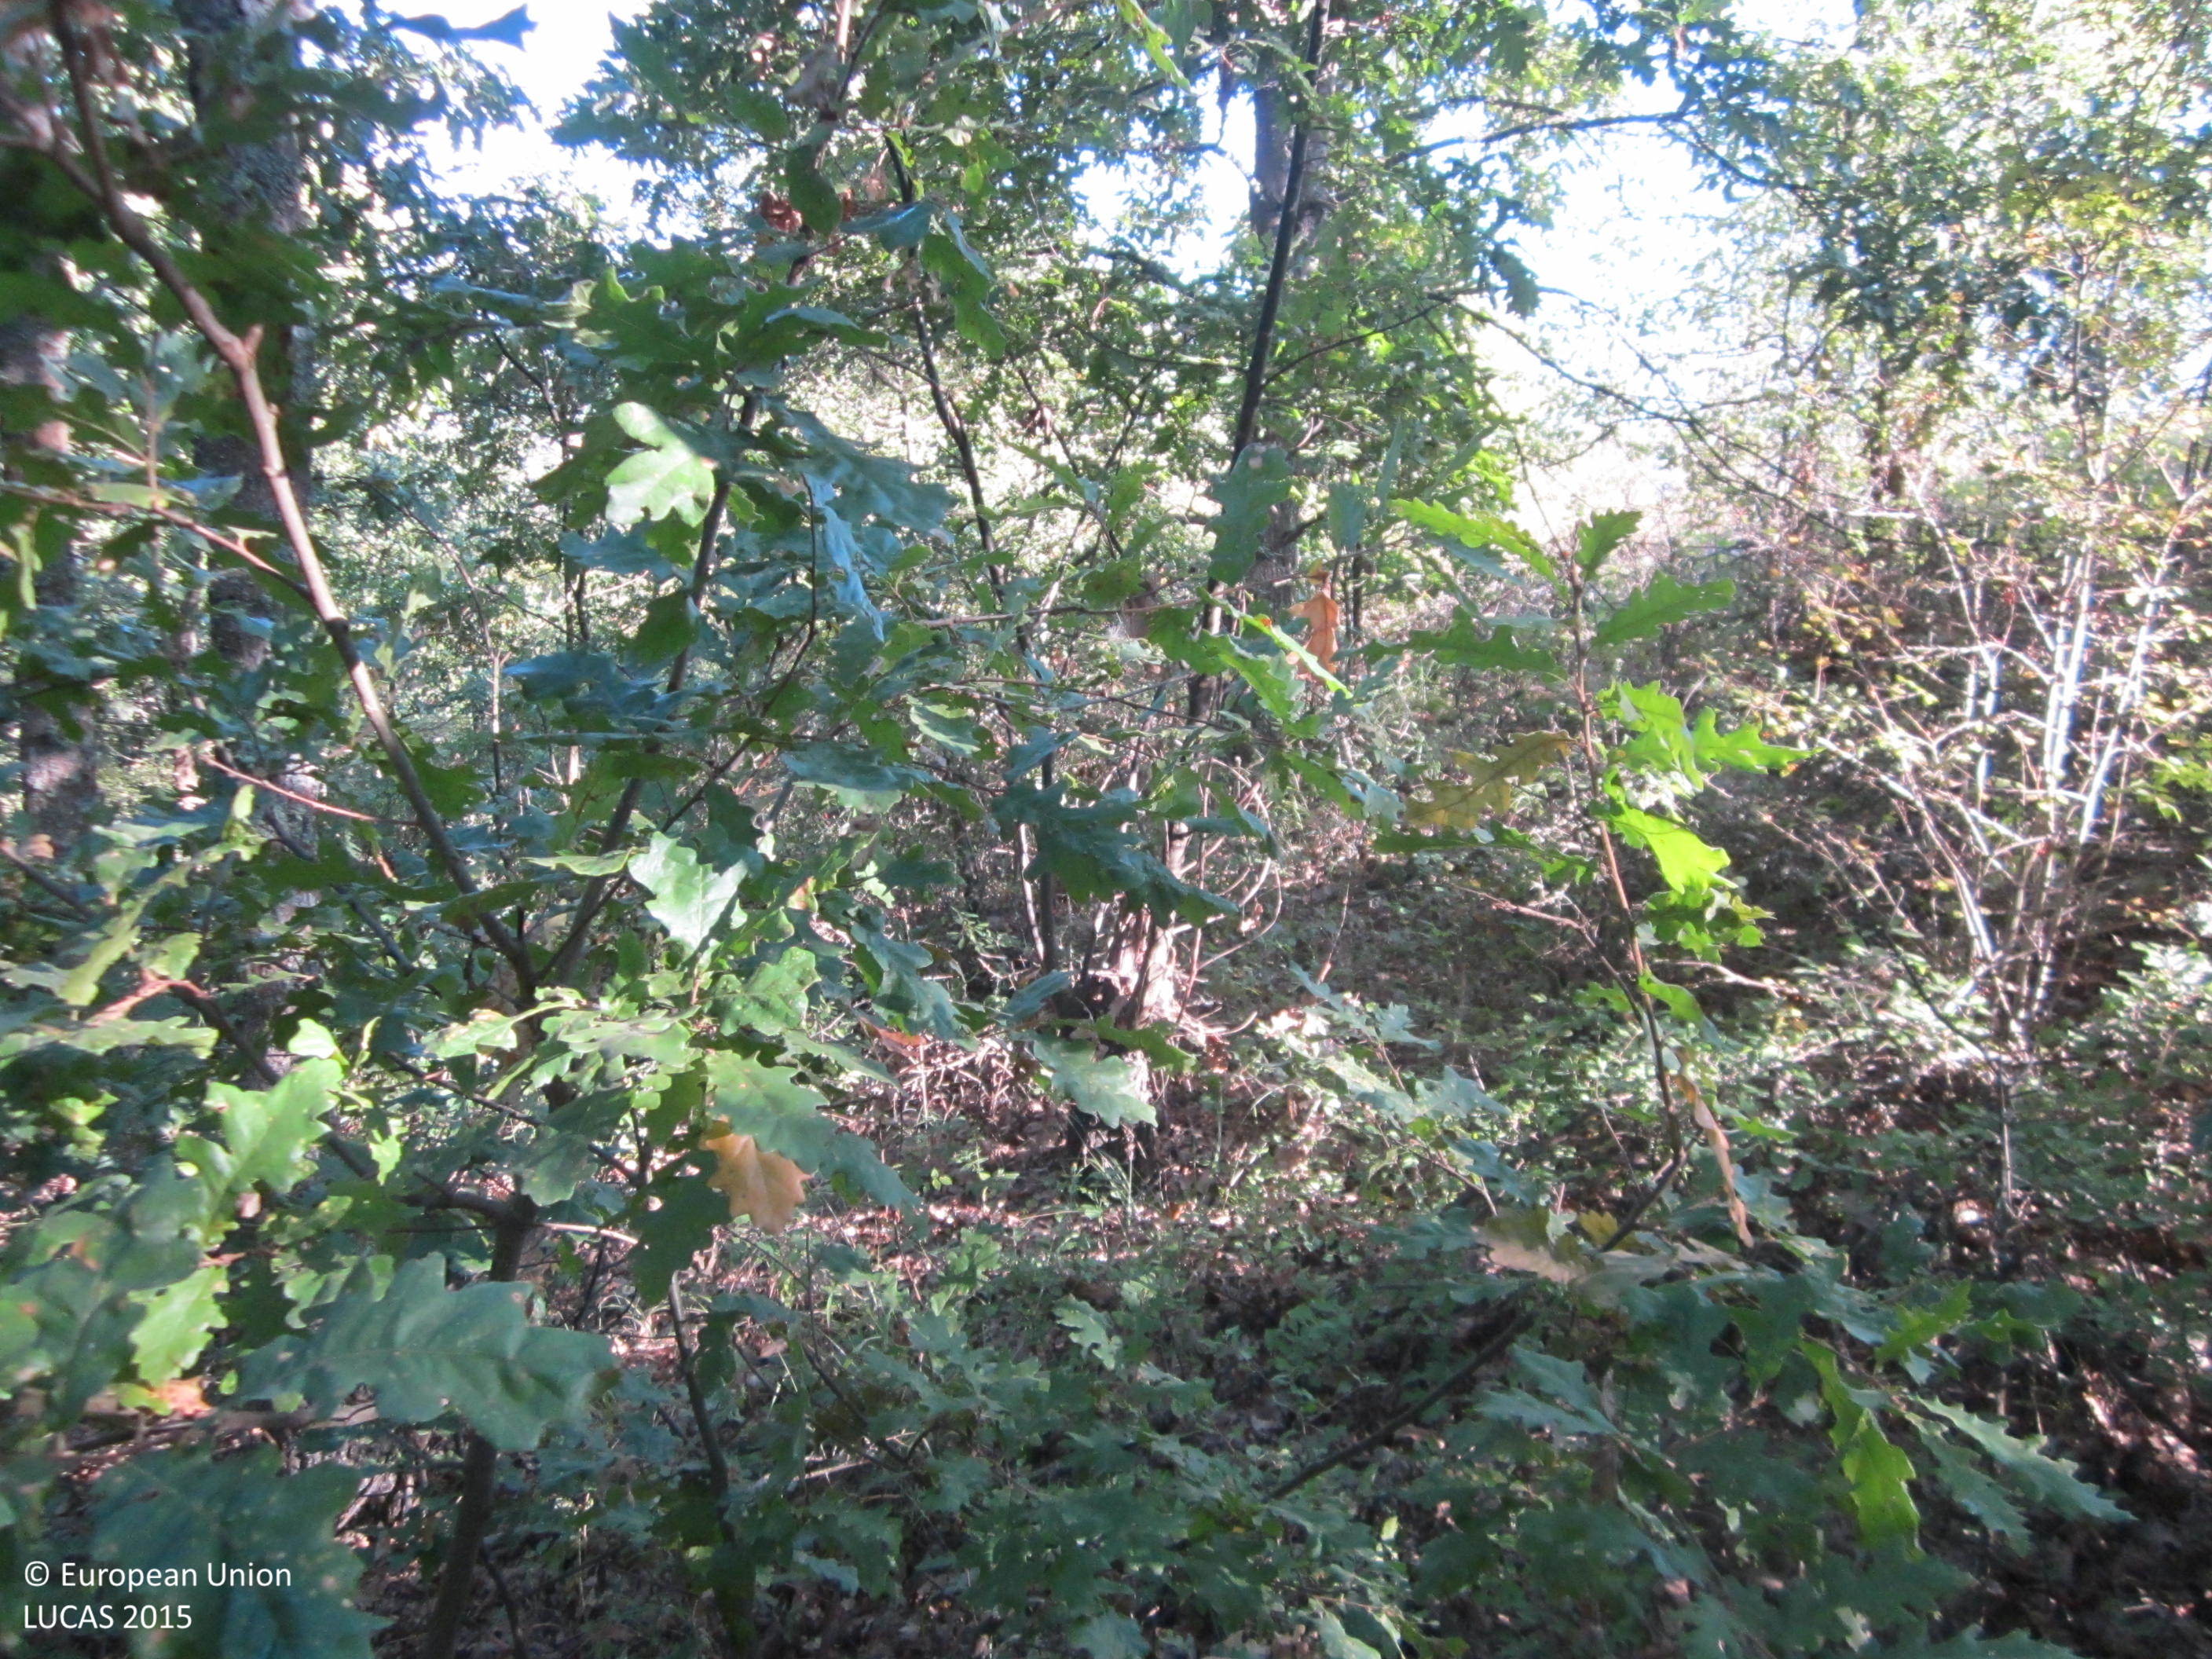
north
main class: Woodland
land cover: Broadleaved woodland
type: thermophilous deciduous forest
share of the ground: > 75 %
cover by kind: broadleaved forest trees 90 %, shrubs 5 %, herbaceous plants 5 %
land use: Forestry
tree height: > 5 m
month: September
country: BG
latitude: 42.1876
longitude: 27.0660
